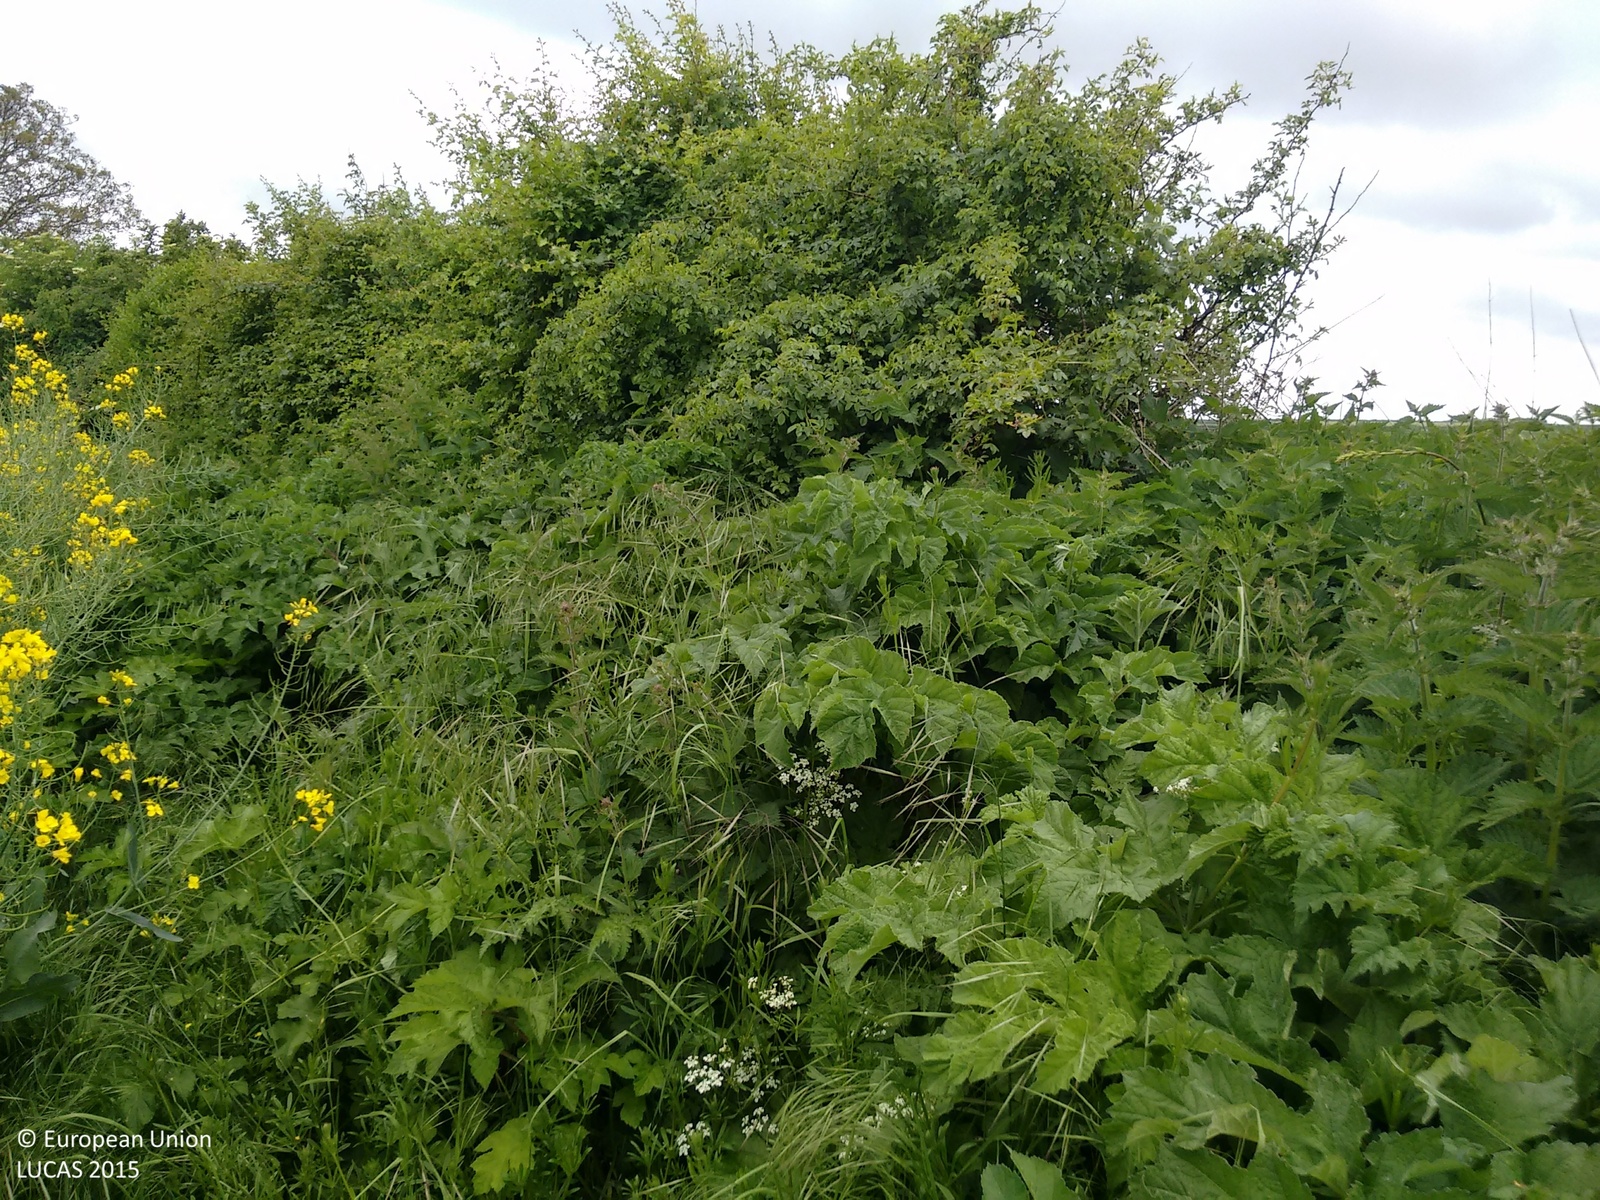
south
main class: Cropland
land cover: Rape and turnip rape
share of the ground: > 75 %
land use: Agriculture (excluding fallow land and kitchen gardens)
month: May
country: GB
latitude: 50.8062
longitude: -2.1364
